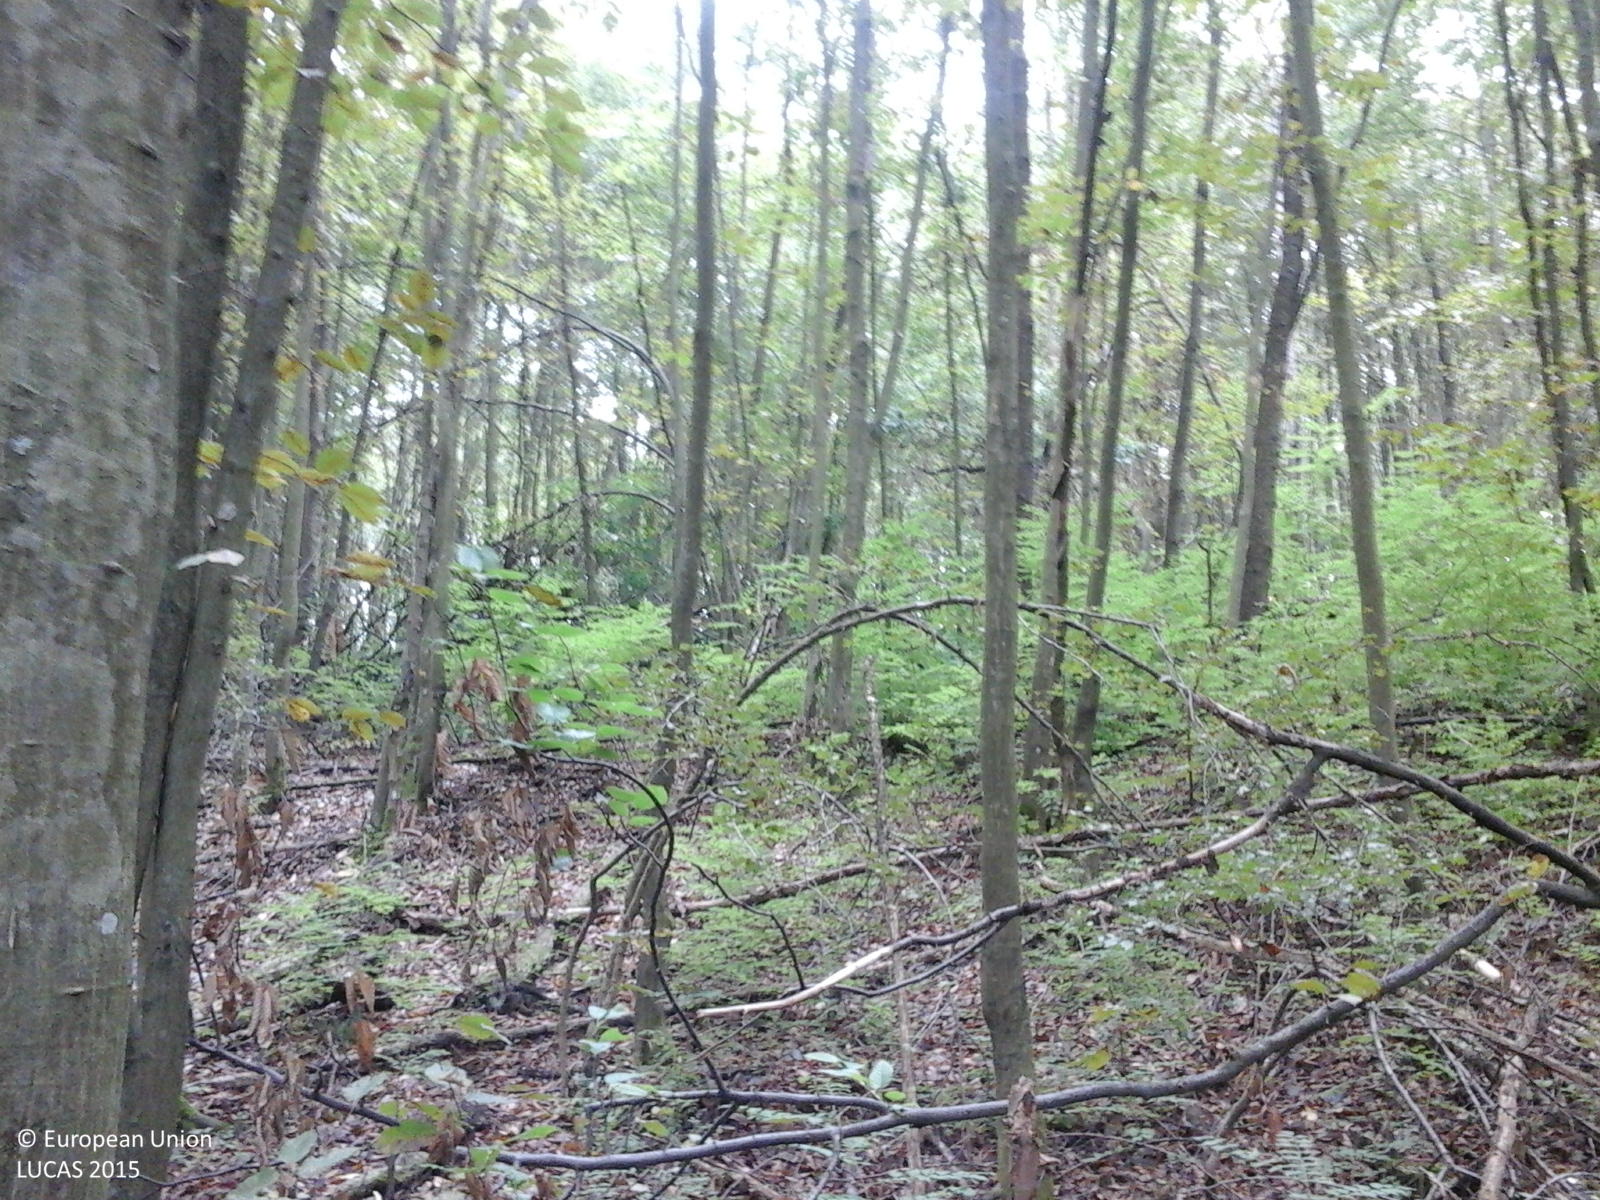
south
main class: Woodland
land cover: Broadleaved woodland
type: mesophytic deciduous forest
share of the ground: > 75 %
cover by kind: broadleaved forest trees 100 %
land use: Forestry
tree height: > 5 m
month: September
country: RO
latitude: 45.9137
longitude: 22.1228
